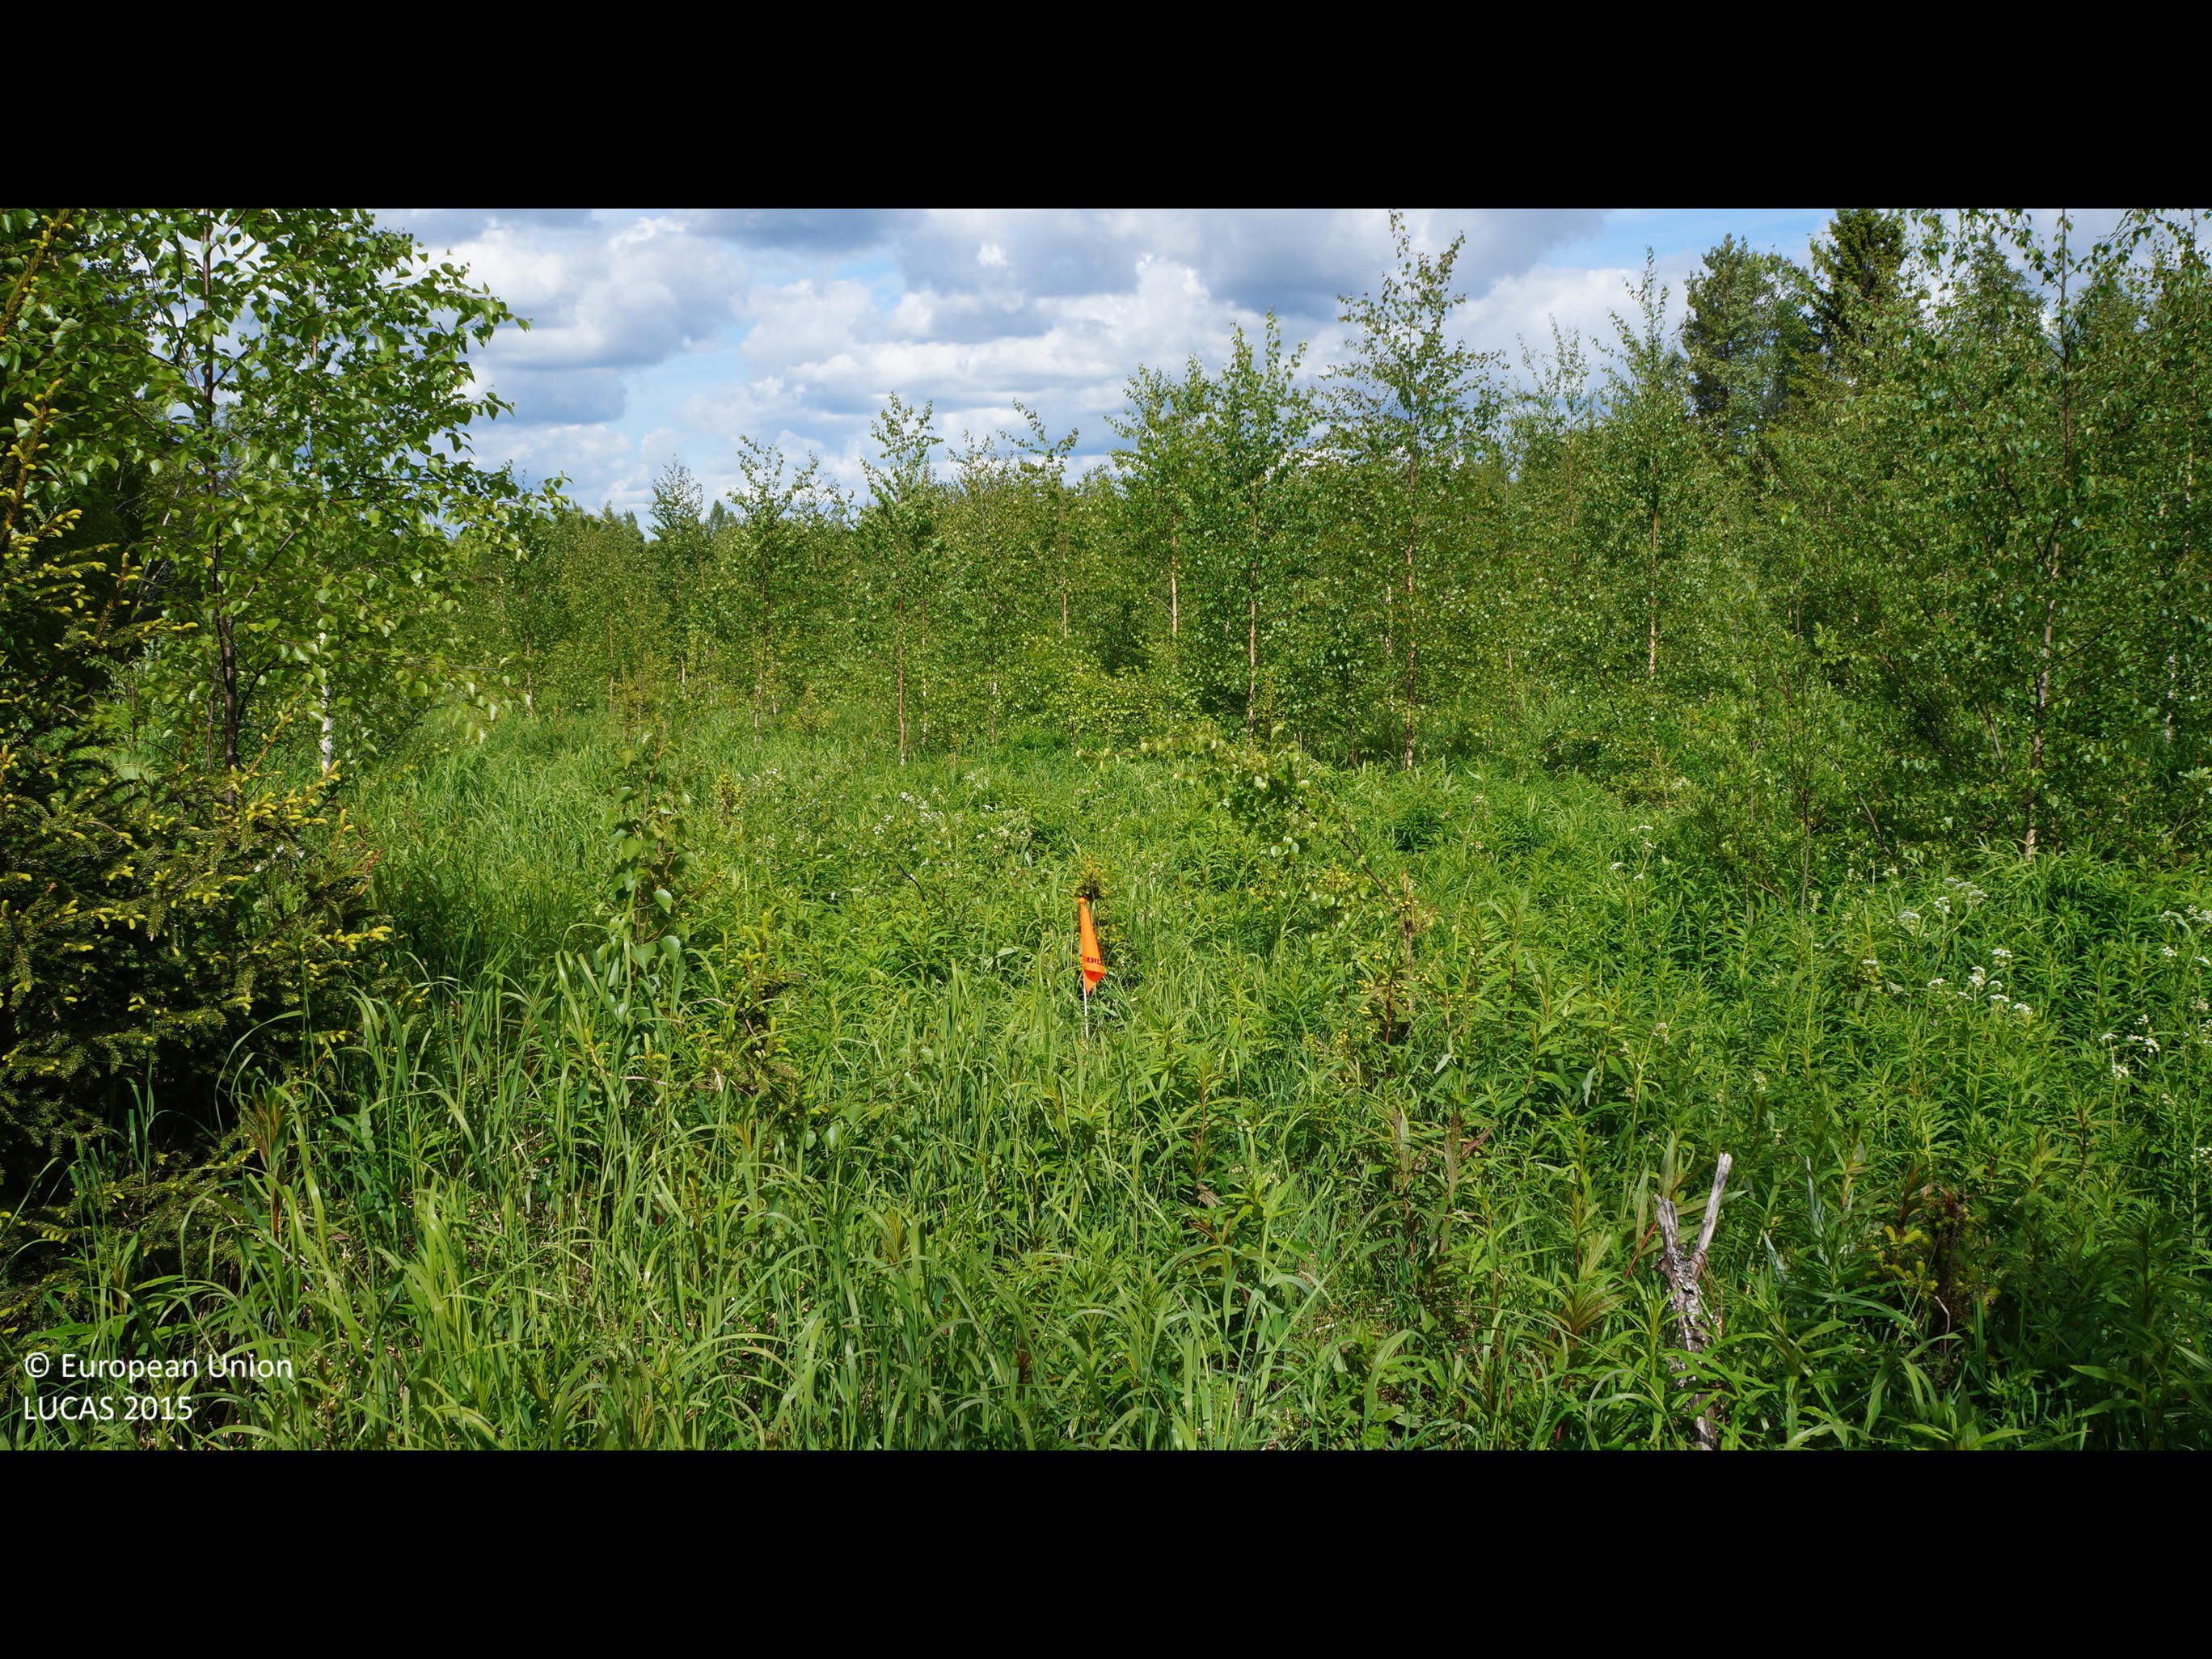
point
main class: Grassland
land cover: Grassland with sparse tree/shrub cover
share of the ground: > 75 %
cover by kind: herbaceous plants 85 %, shrubs 10 %, broadleaved forest trees 5 %
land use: Forestry
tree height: < 5 m
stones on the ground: < 10 %
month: June
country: FI
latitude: 64.1330
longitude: 25.2708
